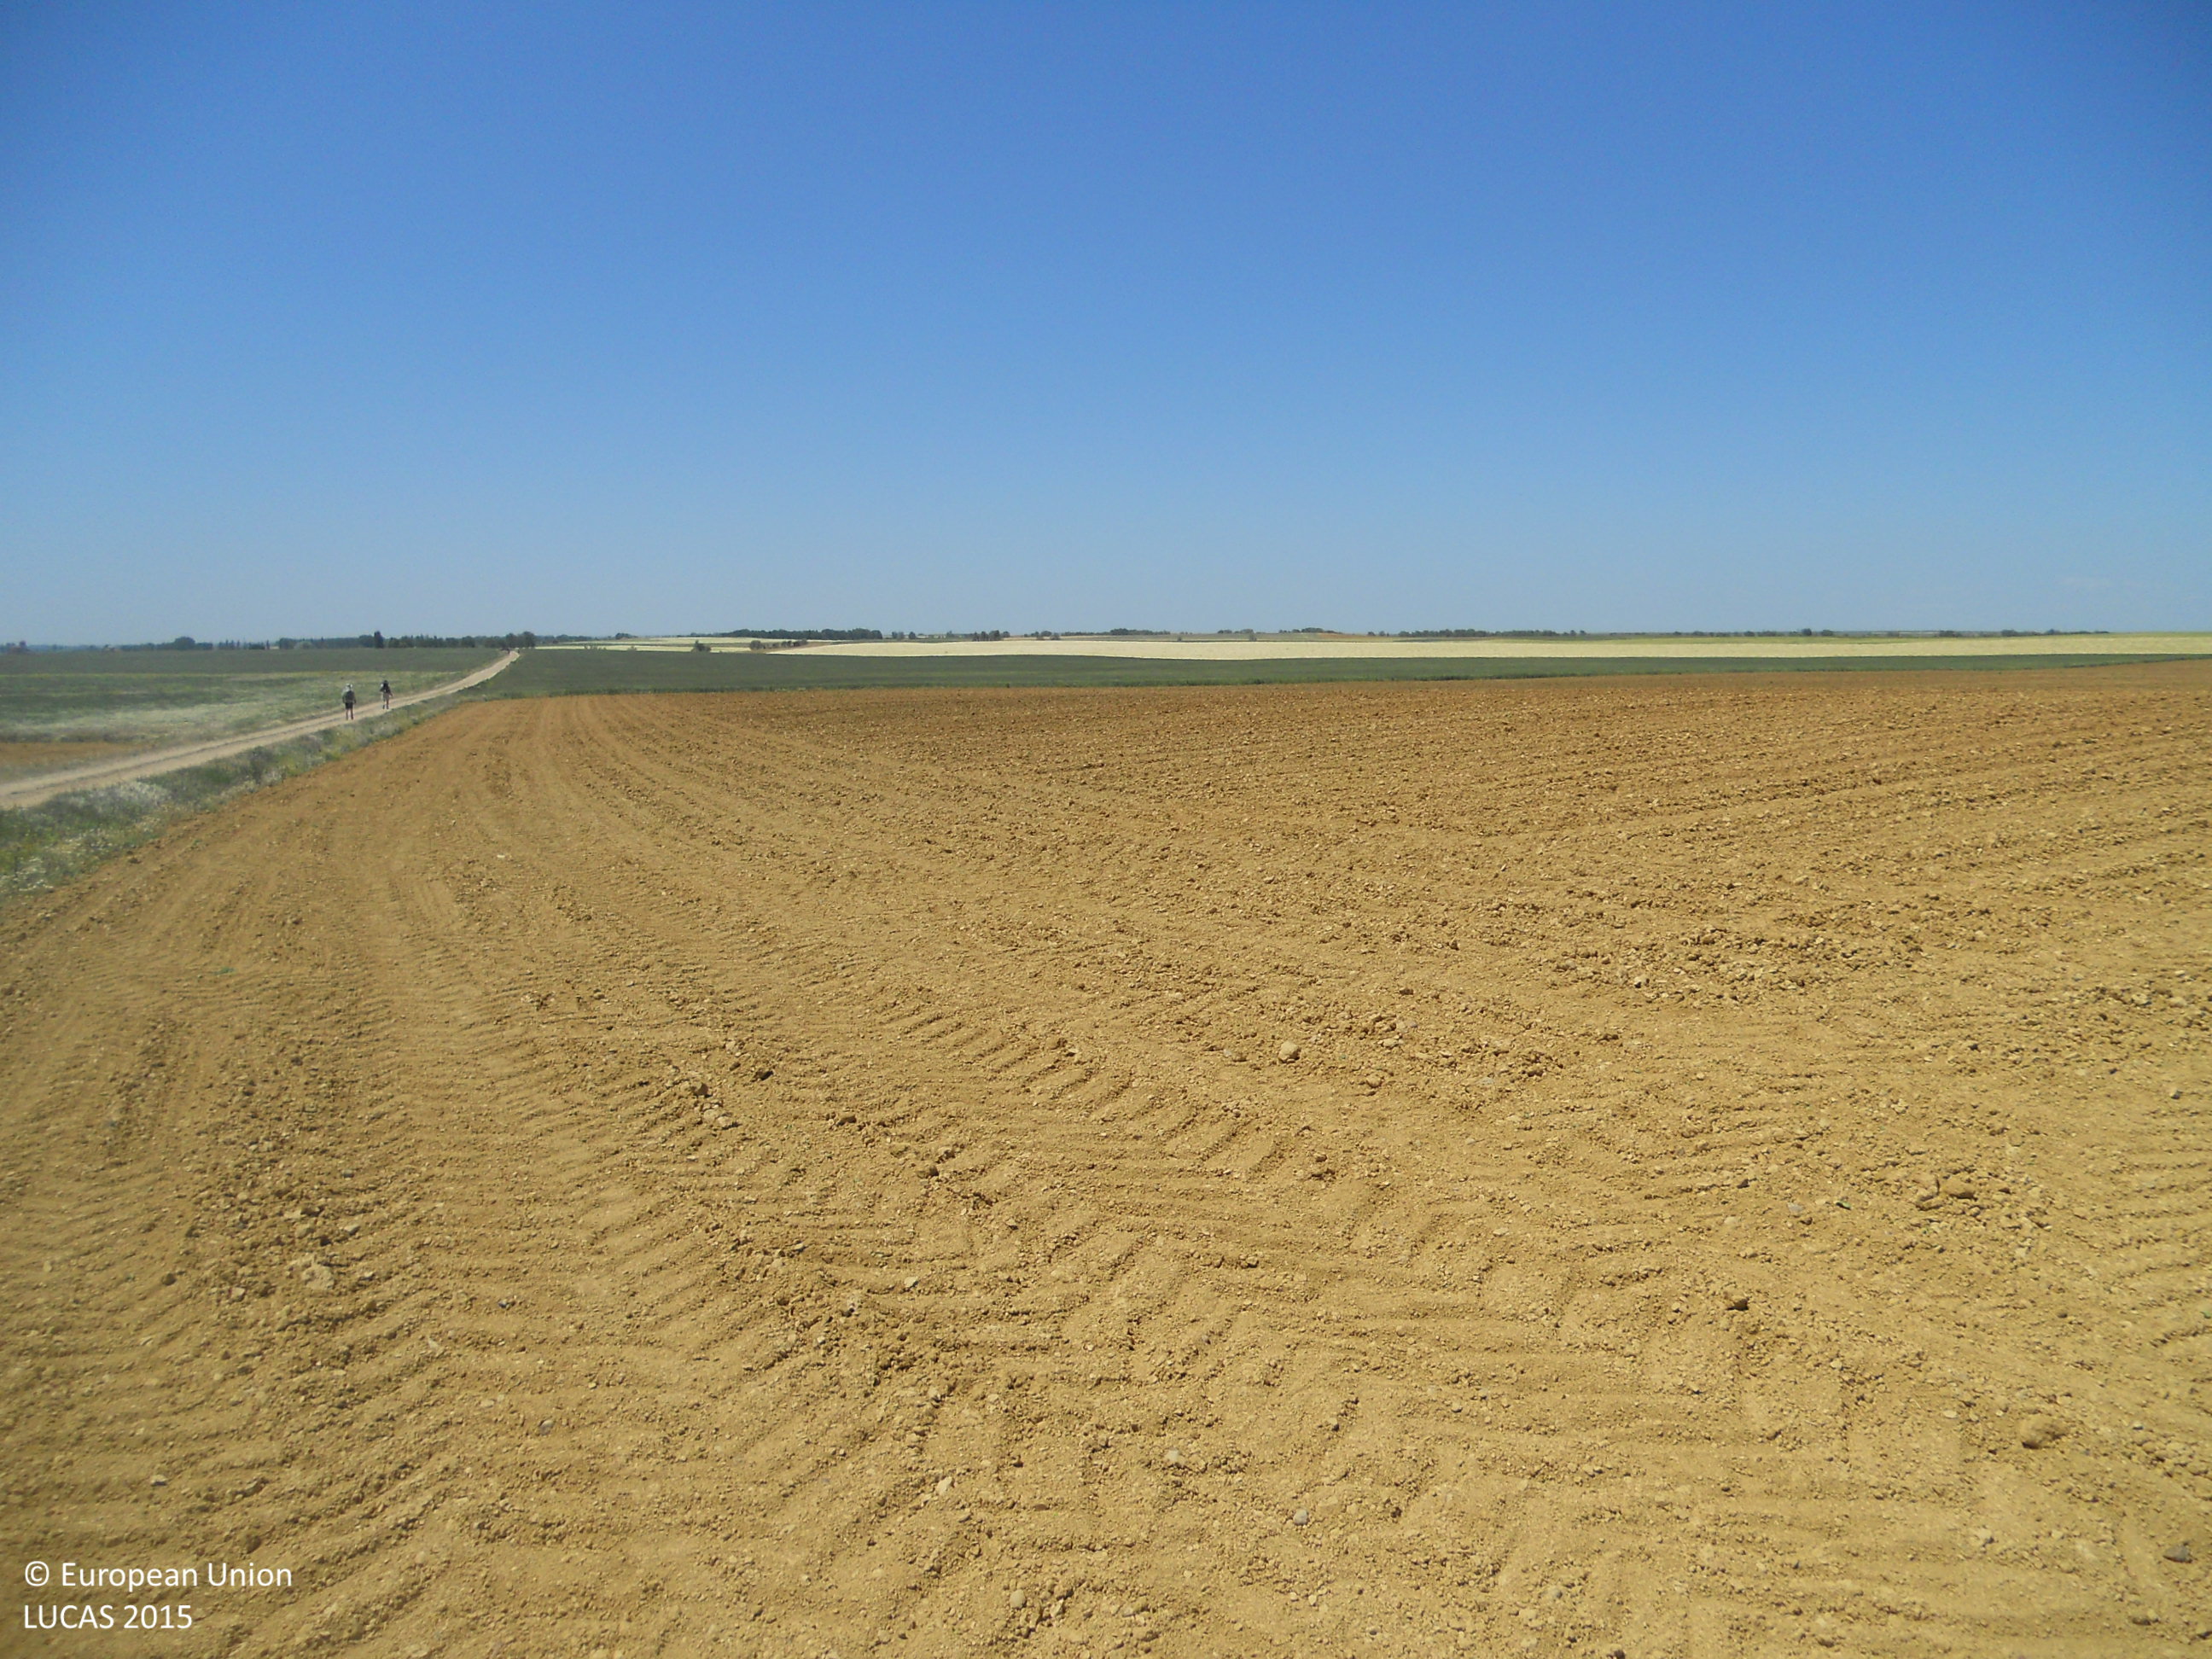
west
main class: Cropland
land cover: Sunflower
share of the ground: < 10 %
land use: Agriculture (excluding fallow land and kitchen gardens)
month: May
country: ES
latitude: 42.2720
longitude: -4.3160
